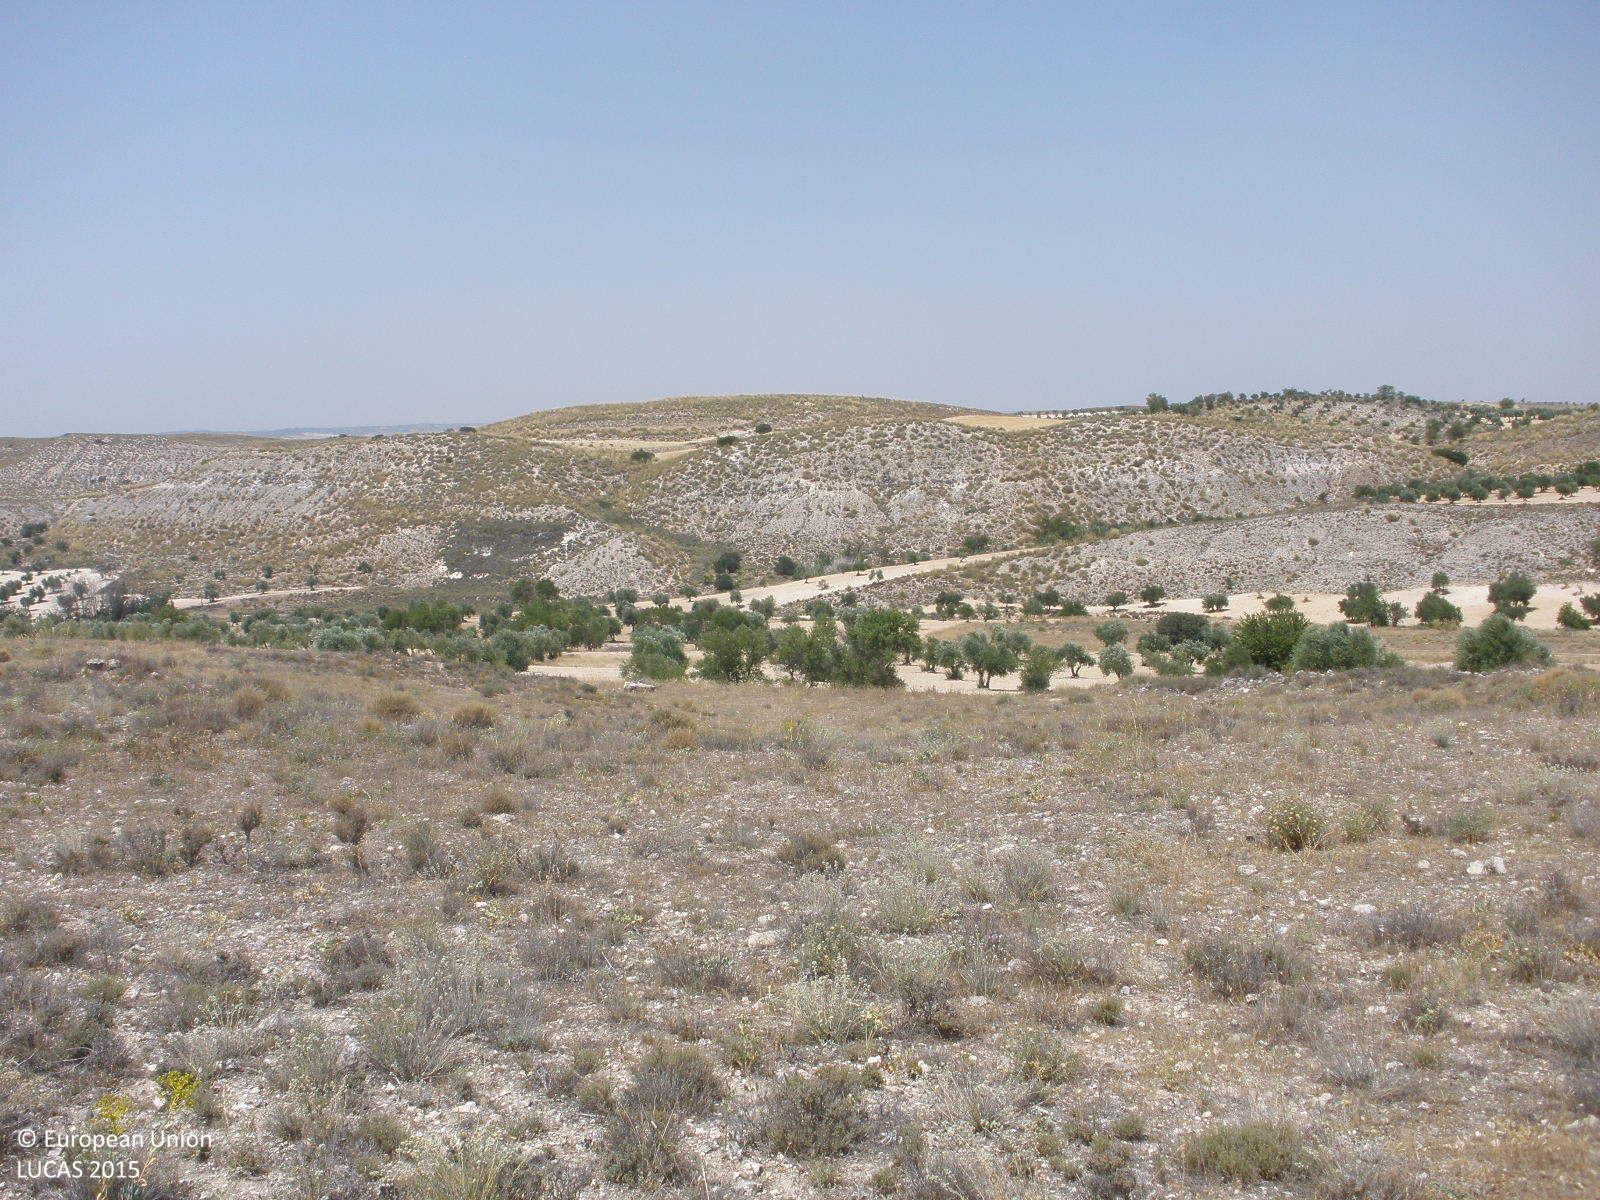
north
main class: Shrubland
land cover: Shrubland without tree cover
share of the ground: 50 - 75 %
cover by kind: shrubs 60 %, herbaceous plants 25 %, consolidated bare surface 15 %
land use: Semi-natural and natural areas not in use
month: July
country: ES
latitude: 39.9870
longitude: -3.2480
